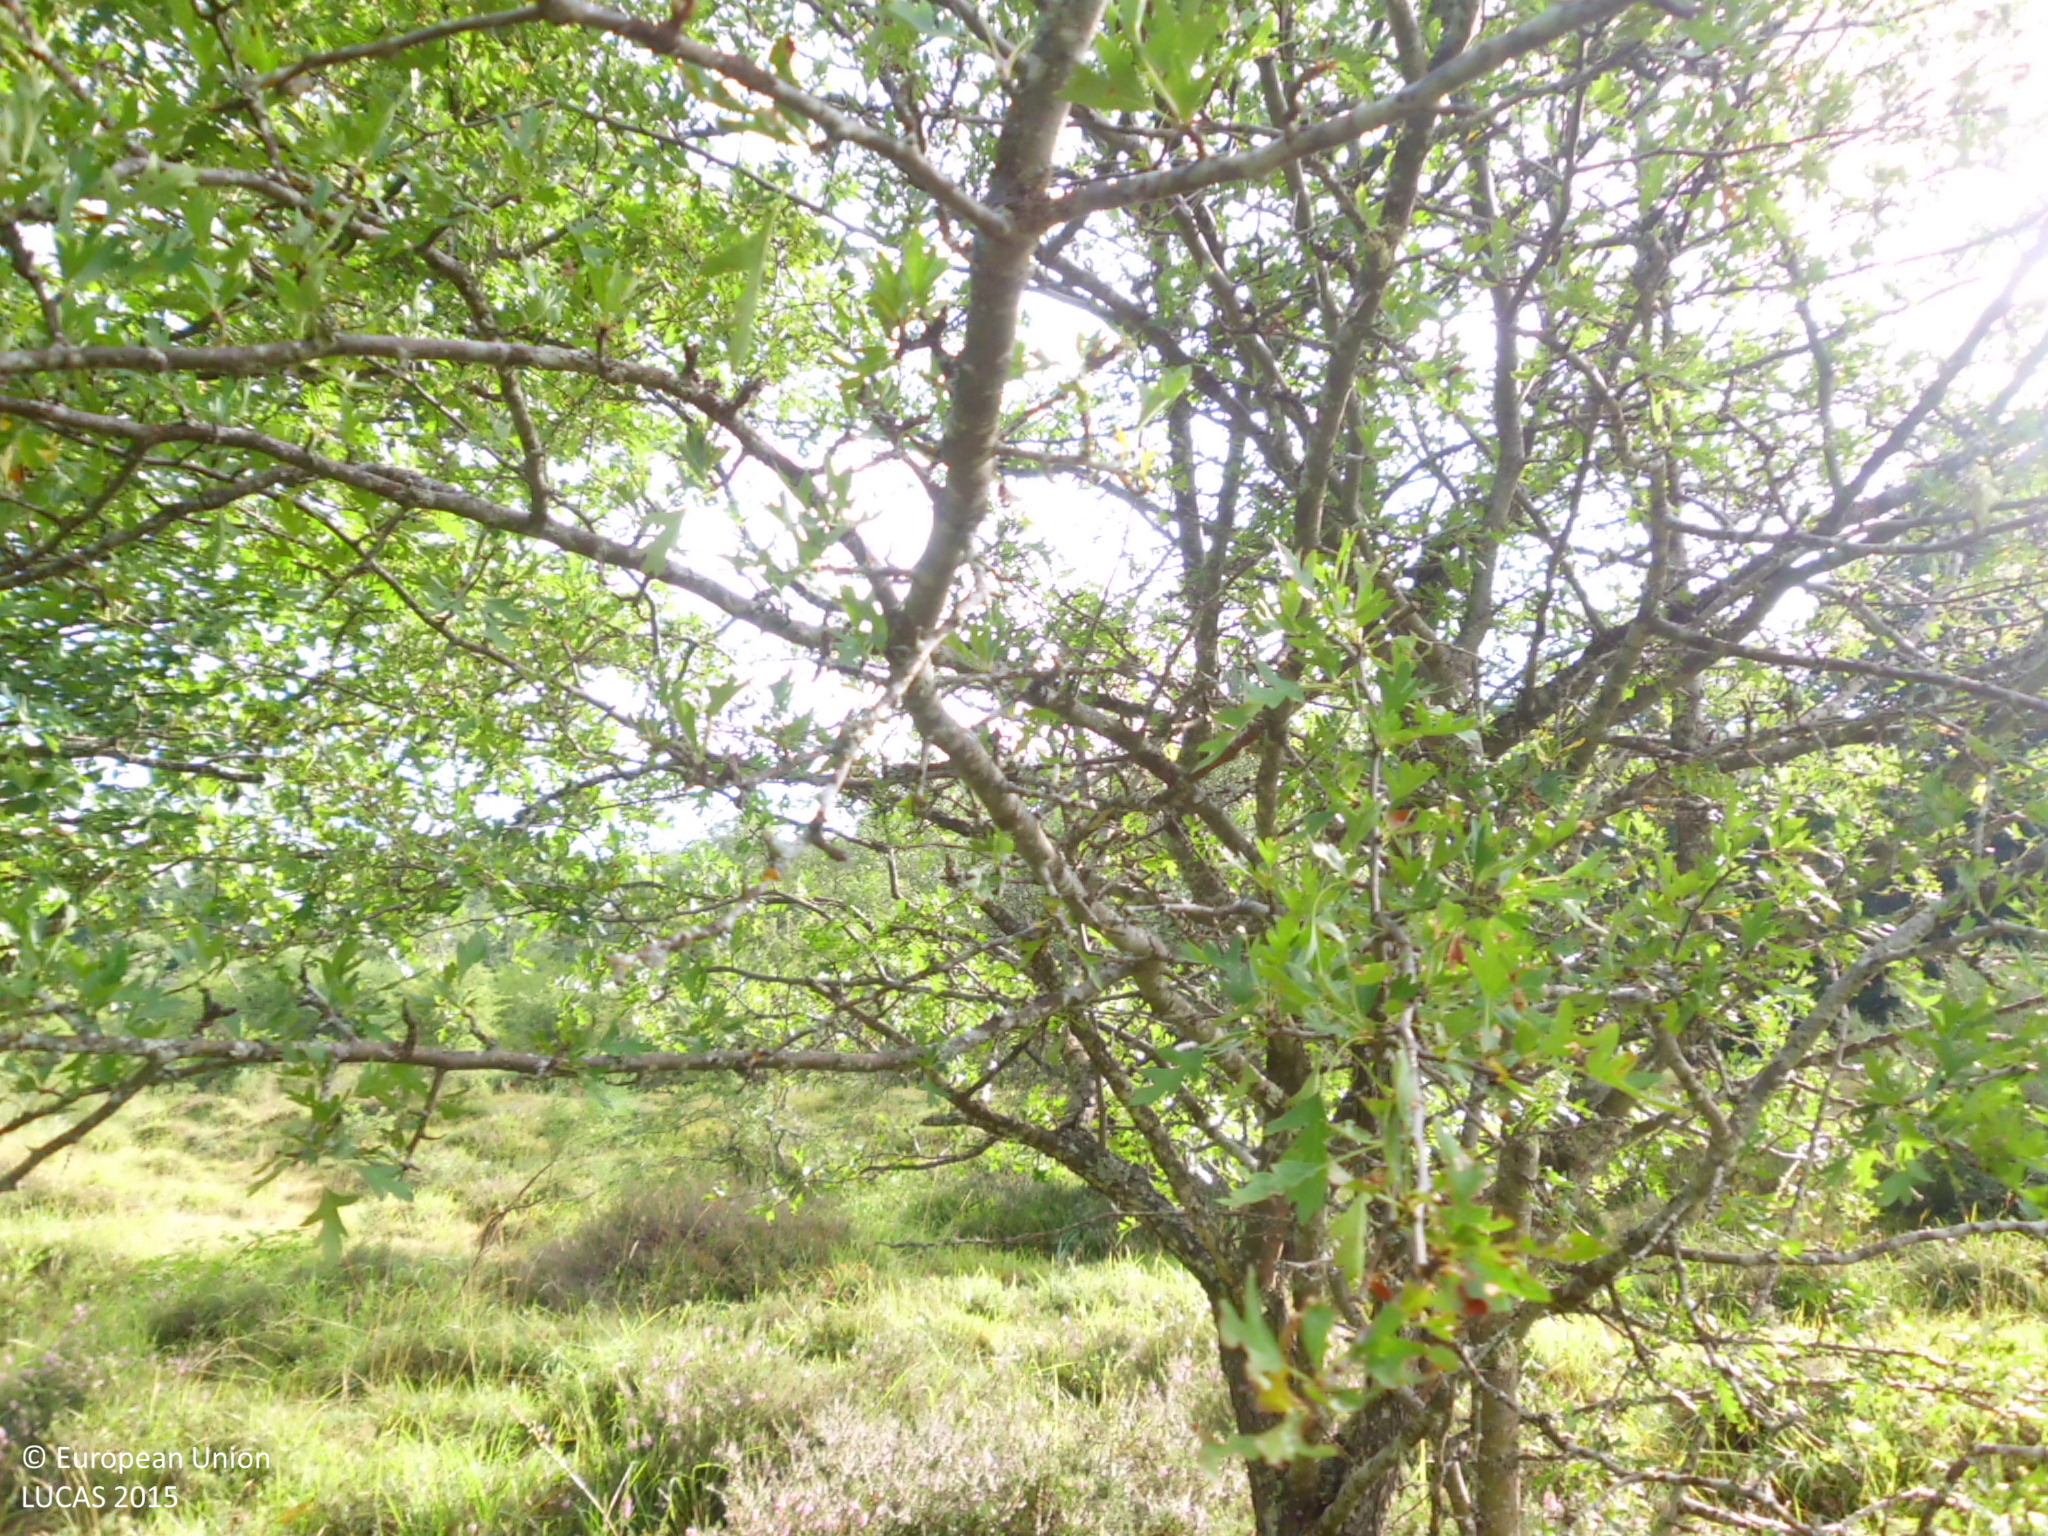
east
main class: Shrubland
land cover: Shrubland with sparse tree cover
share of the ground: 25 - 50 %
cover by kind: herbaceous plants 50 %, shrubs 45 %, broadleaved forest trees 5 %
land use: Agriculture (excluding fallow land and kitchen gardens)
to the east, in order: Shrubland with sparse tree cover; Tracks; Broadleaved woodland
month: July
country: ES
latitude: 42.9937
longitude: -4.5177
